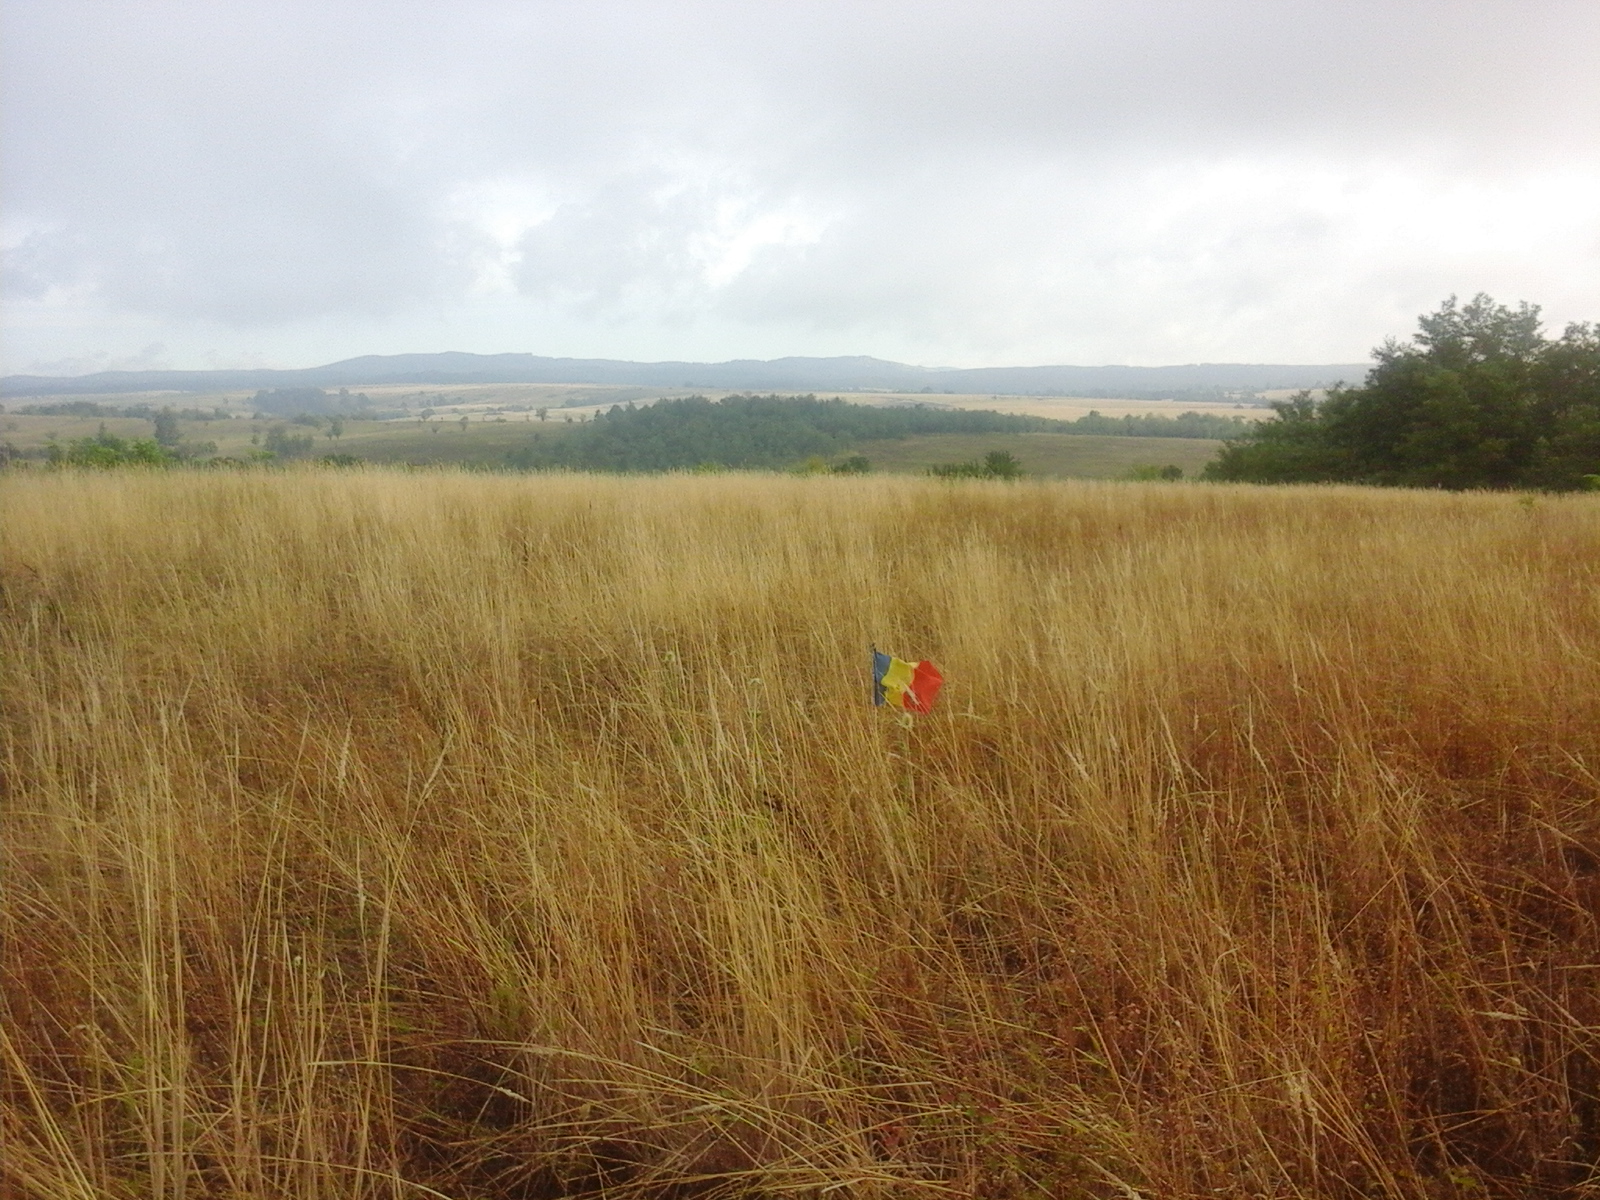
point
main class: Grassland
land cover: Grassland without tree/shrub cover
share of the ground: > 75 %
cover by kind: herbaceous plants 100 %
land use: Agriculture (excluding fallow land and kitchen gardens)
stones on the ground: < 10 %
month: August
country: RO
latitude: 45.1666
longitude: 21.6479
